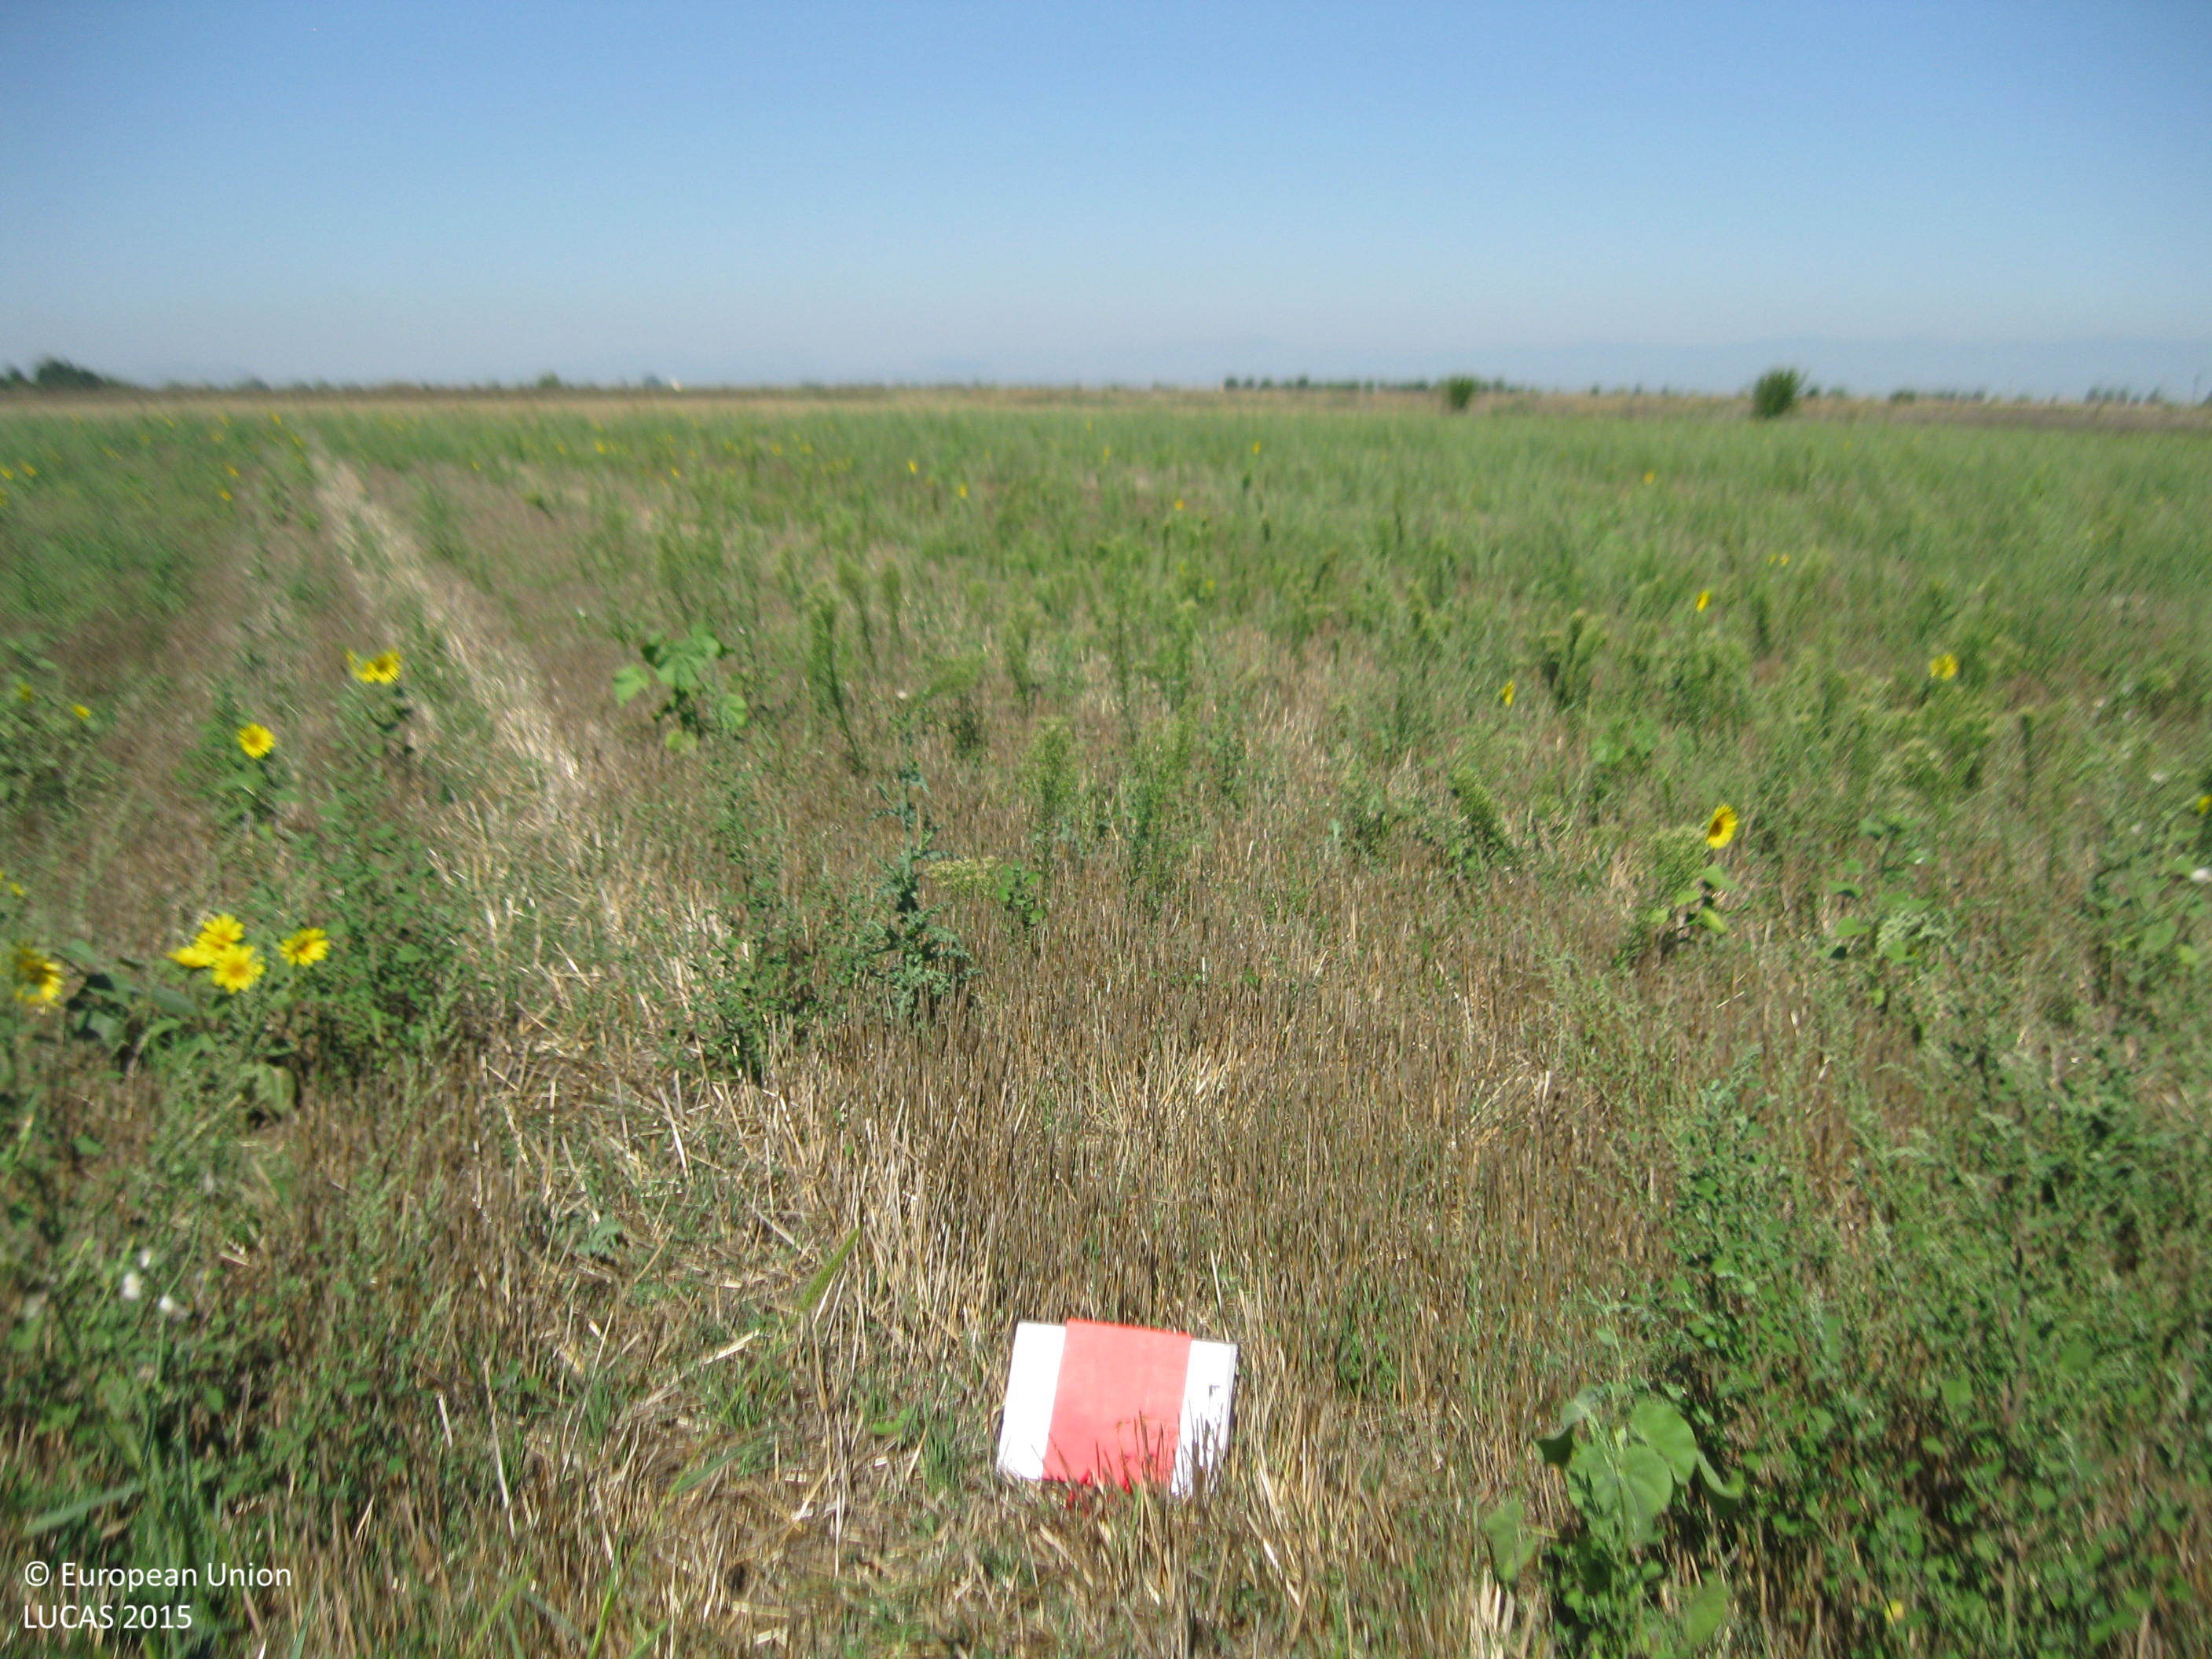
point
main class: Cropland
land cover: Common wheat
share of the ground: 25 - 50 %
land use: Agriculture (excluding fallow land and kitchen gardens)
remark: Harvested field
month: September
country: BG
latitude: 42.2094
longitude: 24.6214
